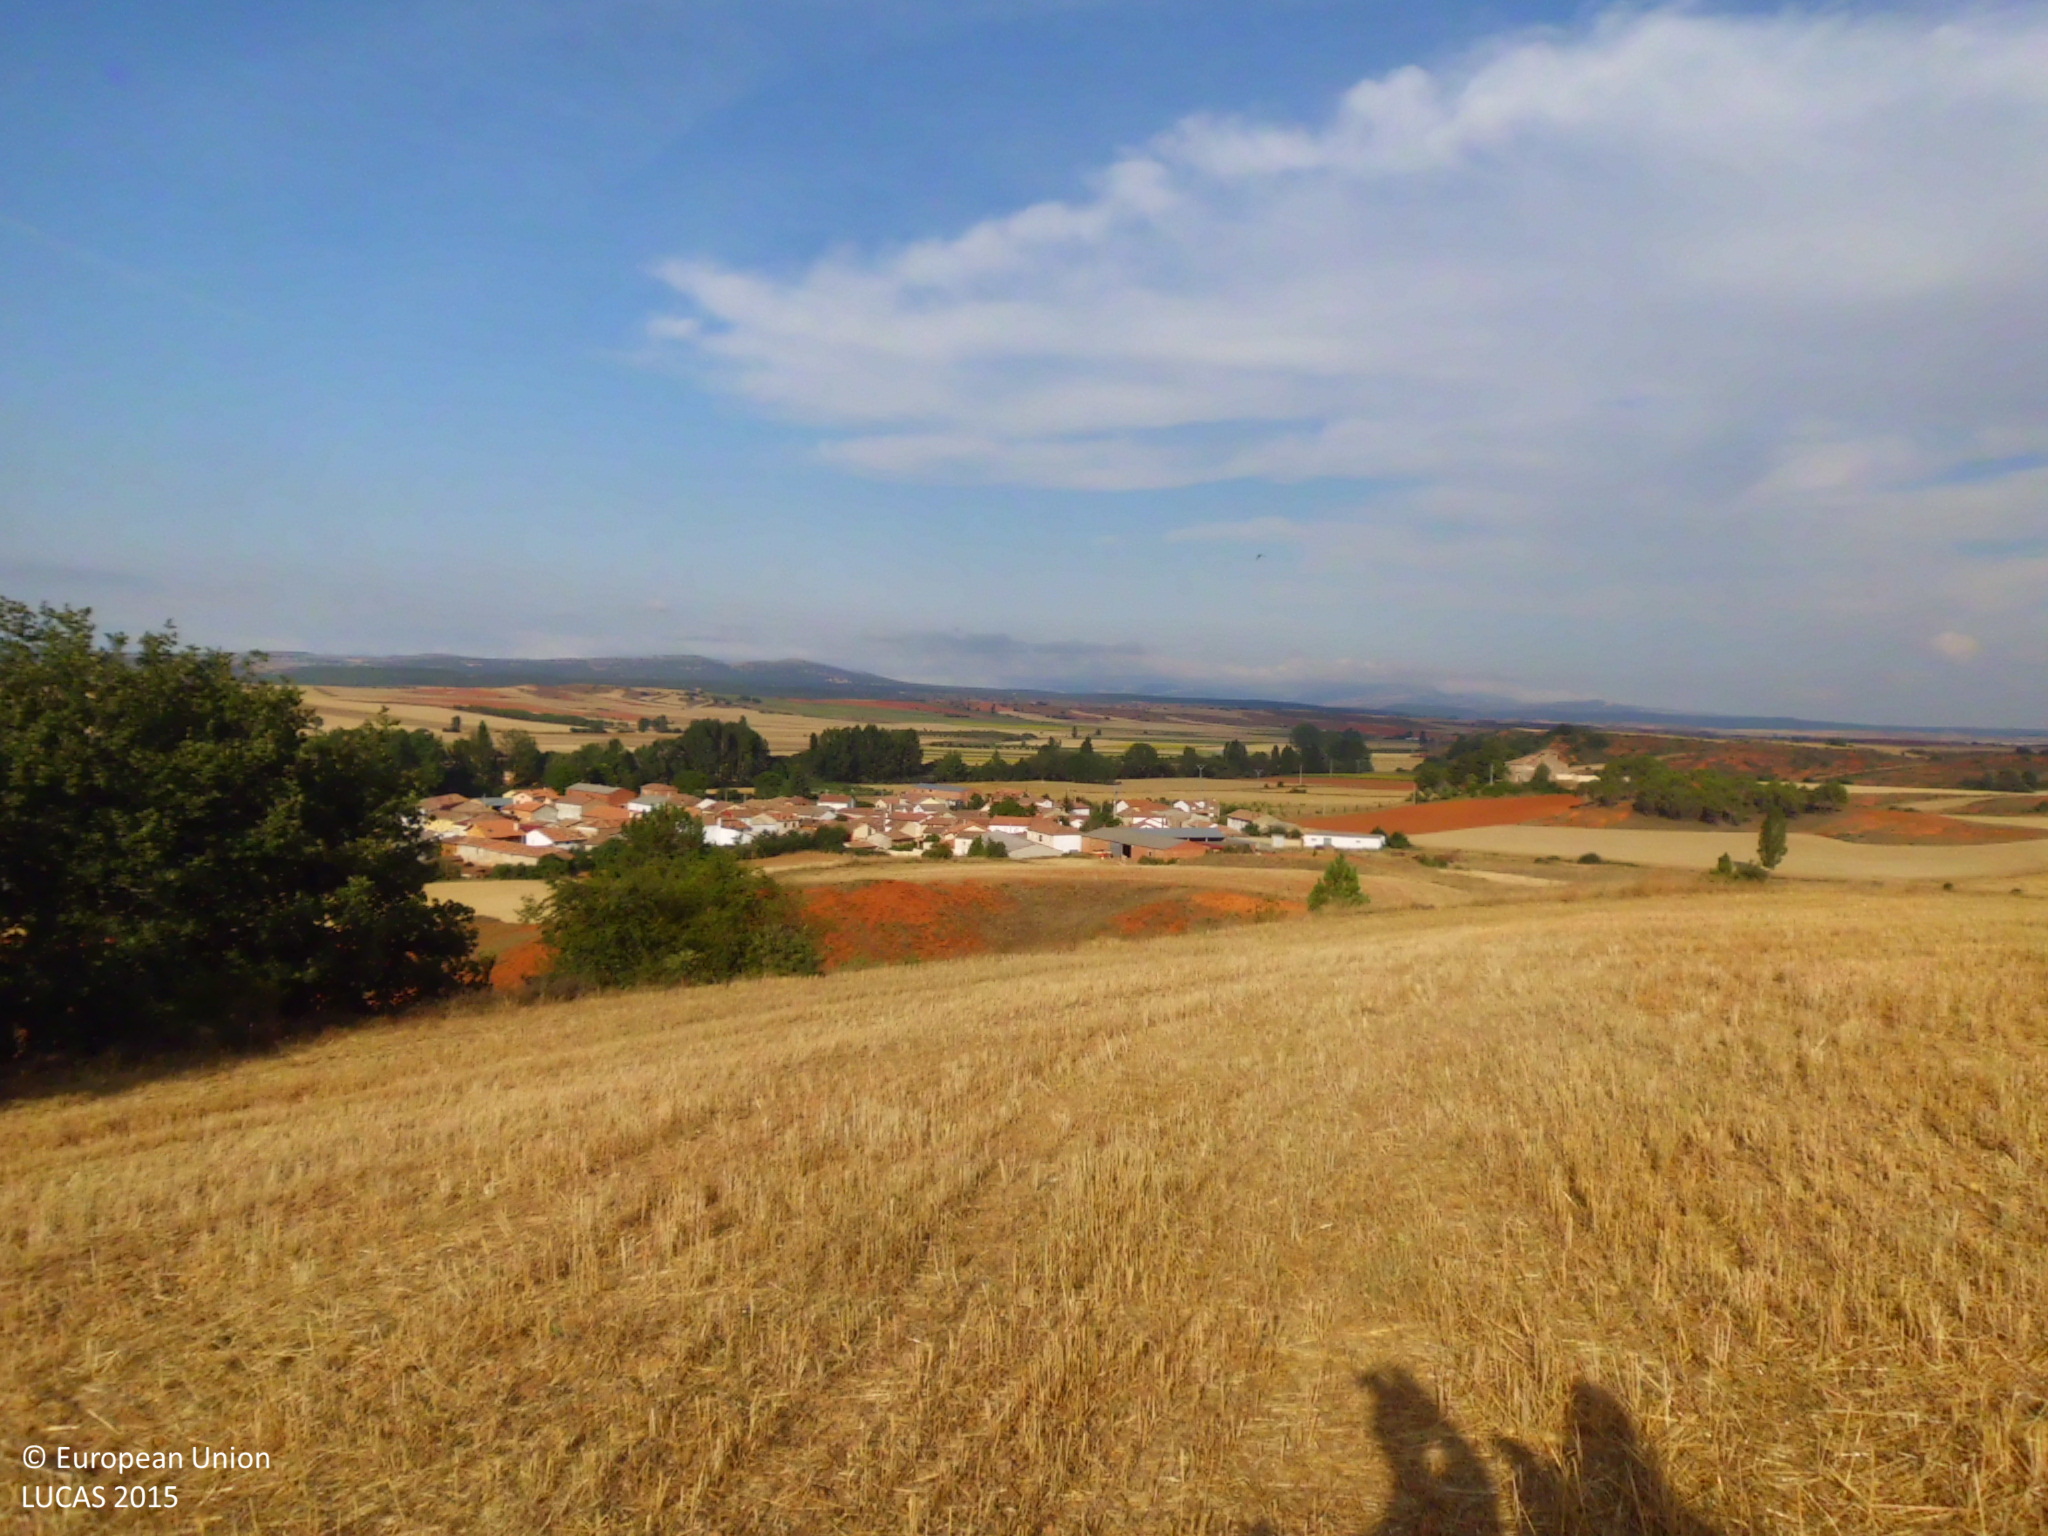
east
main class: Cropland
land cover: Oats
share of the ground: < 10 %
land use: Agriculture (excluding fallow land and kitchen gardens)
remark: Harvested field
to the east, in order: Oats; Shrubland without tree cover; Oats; Grassland without tree/shrub cover
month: July
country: ES
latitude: 42.6897
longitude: -4.4672
